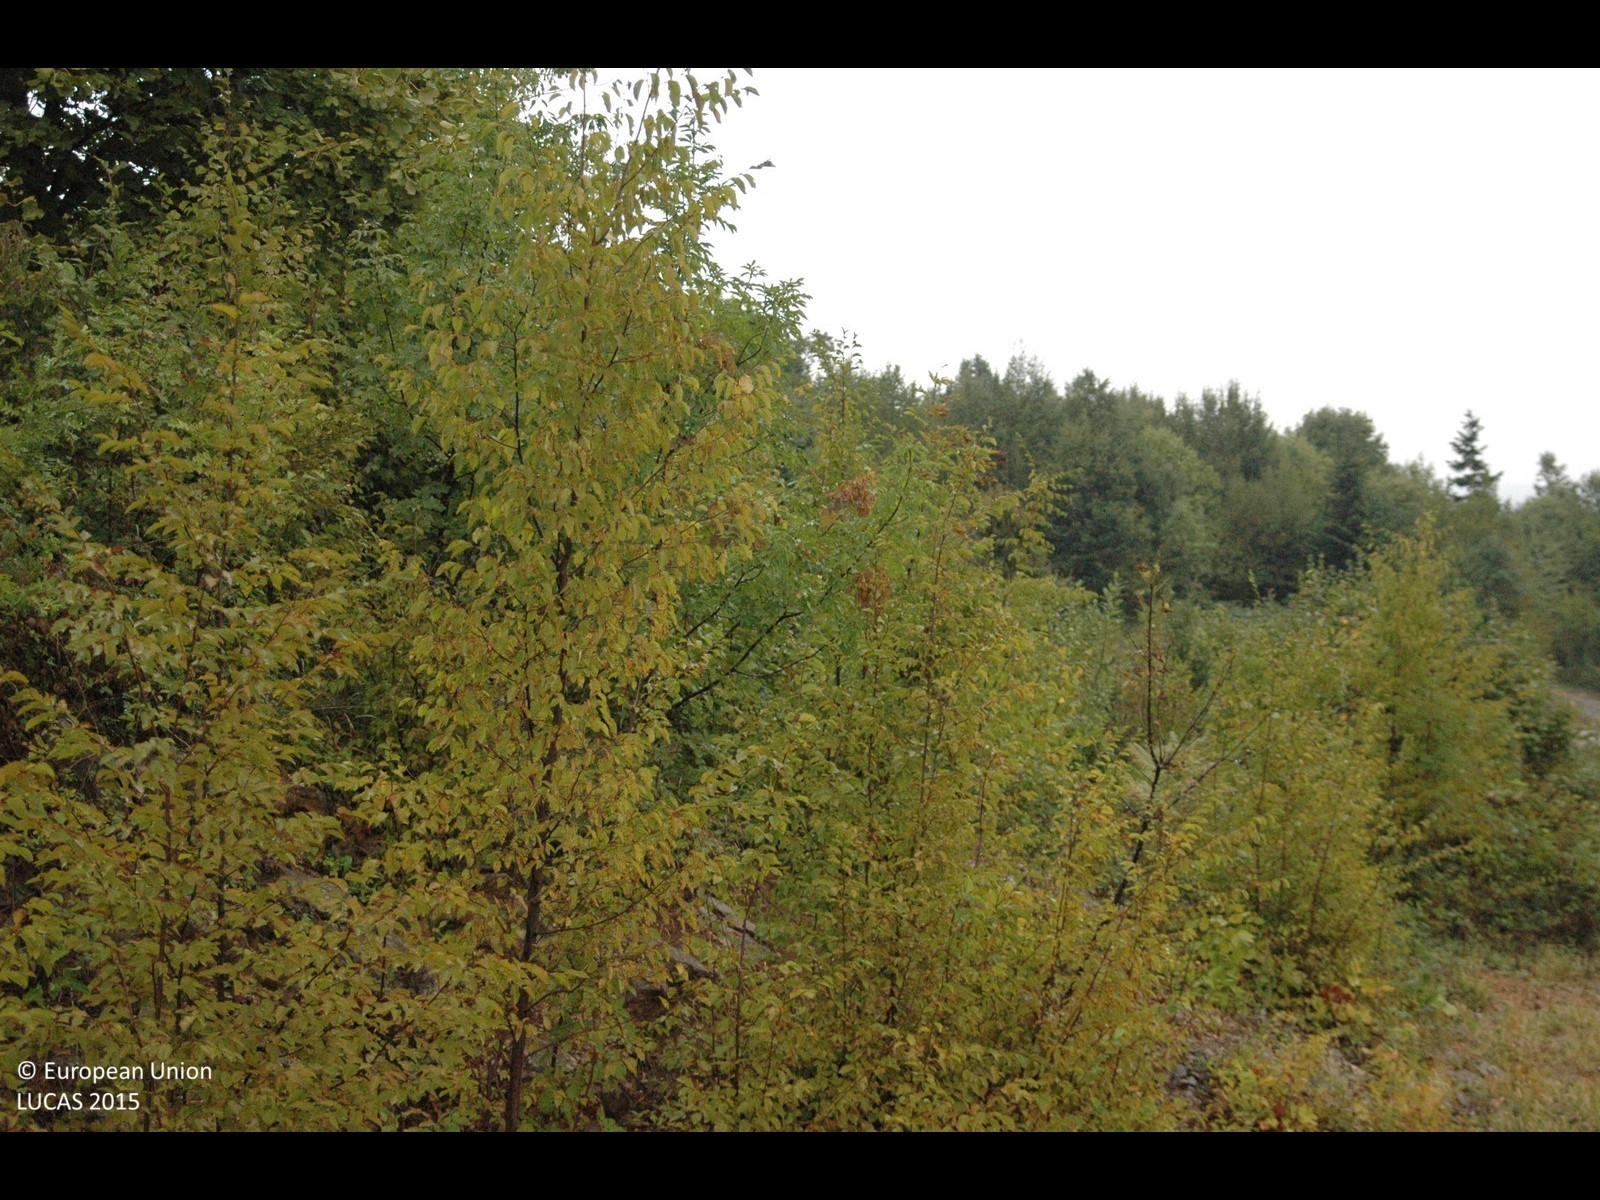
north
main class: Woodland
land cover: Broadleaved woodland
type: beech forest
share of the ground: > 75 %
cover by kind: broadleaved forest trees 100 %
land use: Forestry
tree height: > 5 m
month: October
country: HR
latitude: 45.1739
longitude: 15.2757
